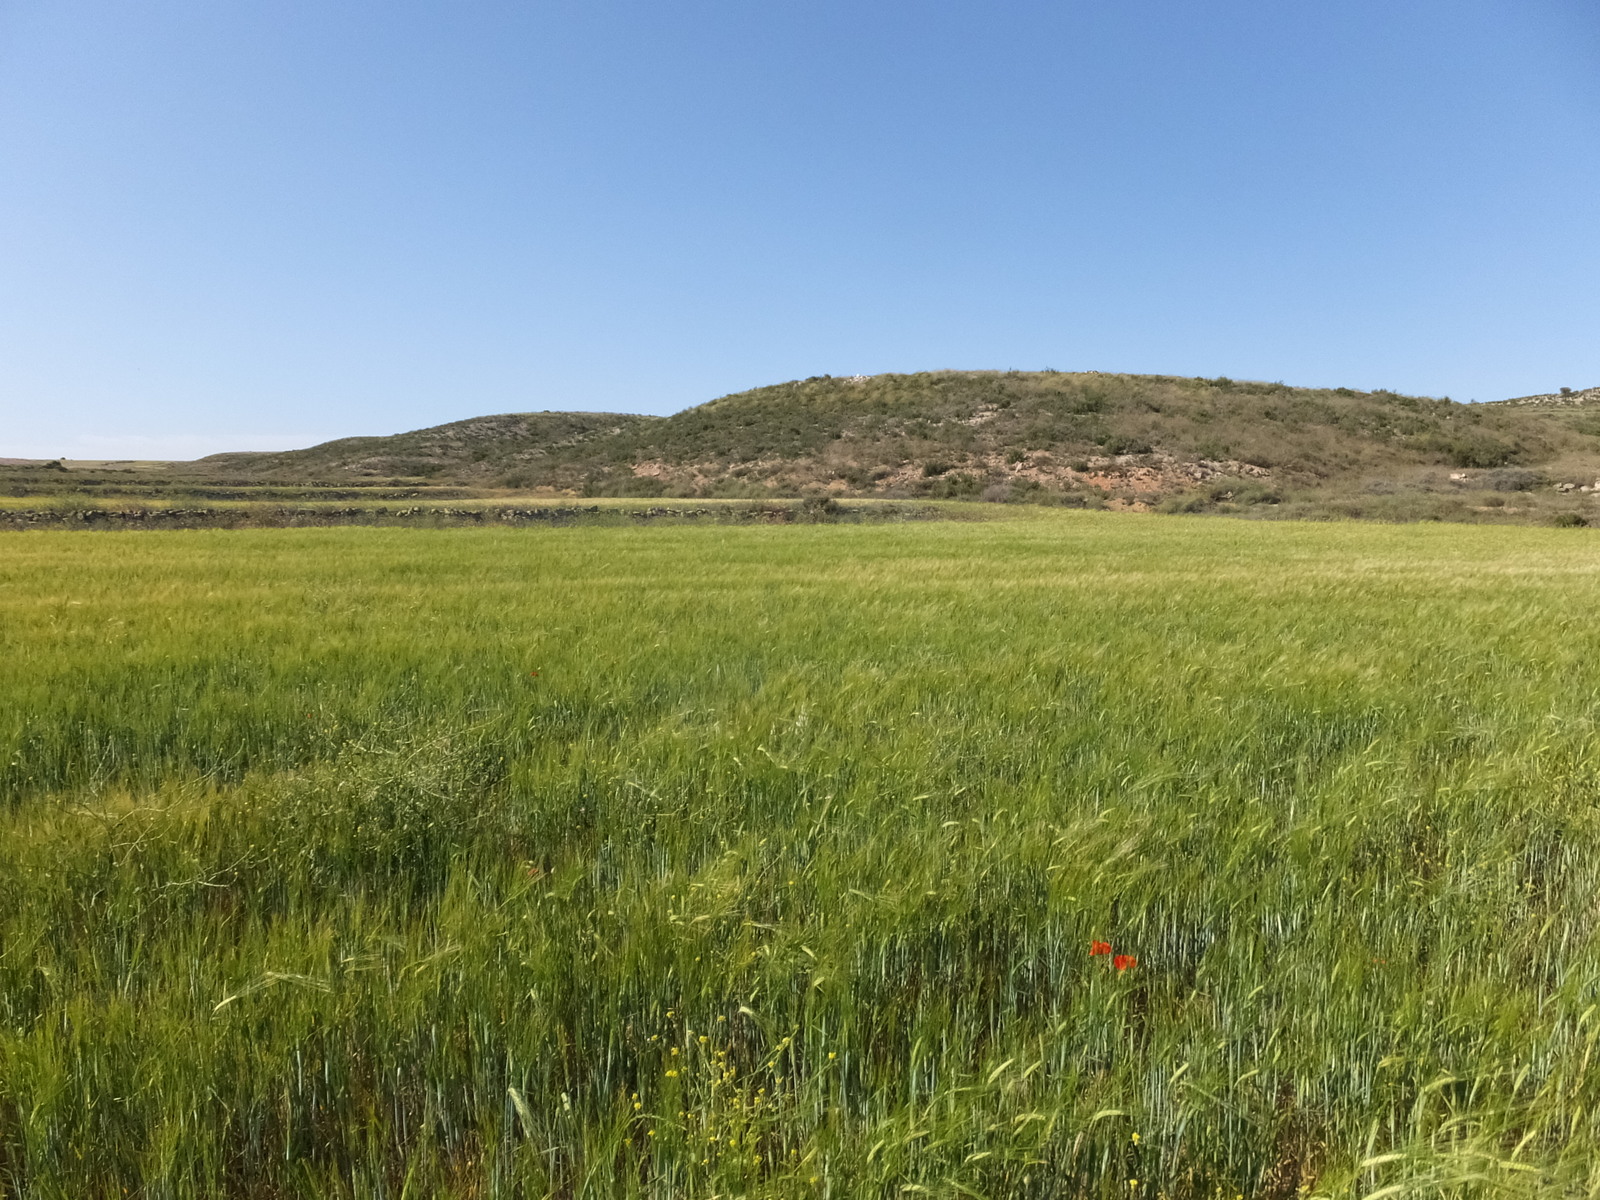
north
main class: Cropland
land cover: Barley
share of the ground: > 75 %
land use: Agriculture (excluding fallow land and kitchen gardens)
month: May
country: ES
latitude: 41.3624
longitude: -0.3078
